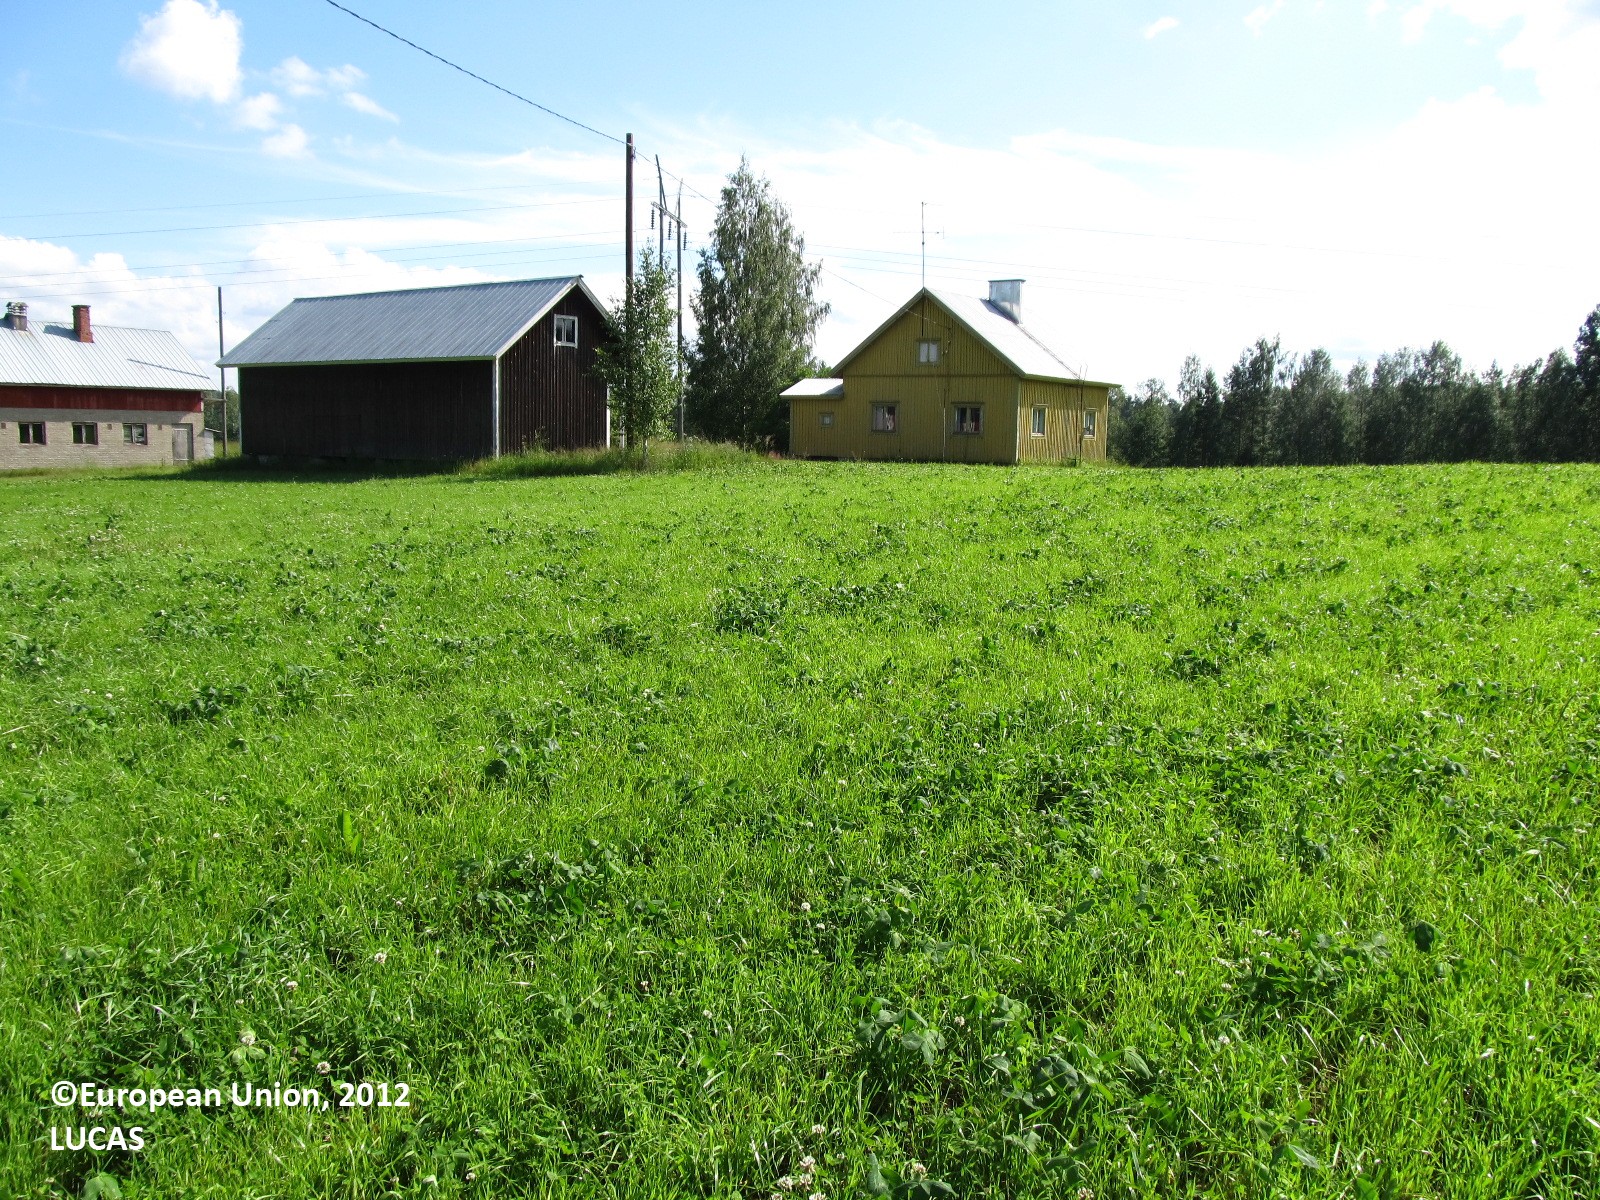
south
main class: Grassland
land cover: Spontaneously vegetated surfaces
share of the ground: > 75 %
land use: Agriculture (excluding fallow land and kitchen gardens)
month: July
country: FI
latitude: 61.9230
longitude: 28.4318
